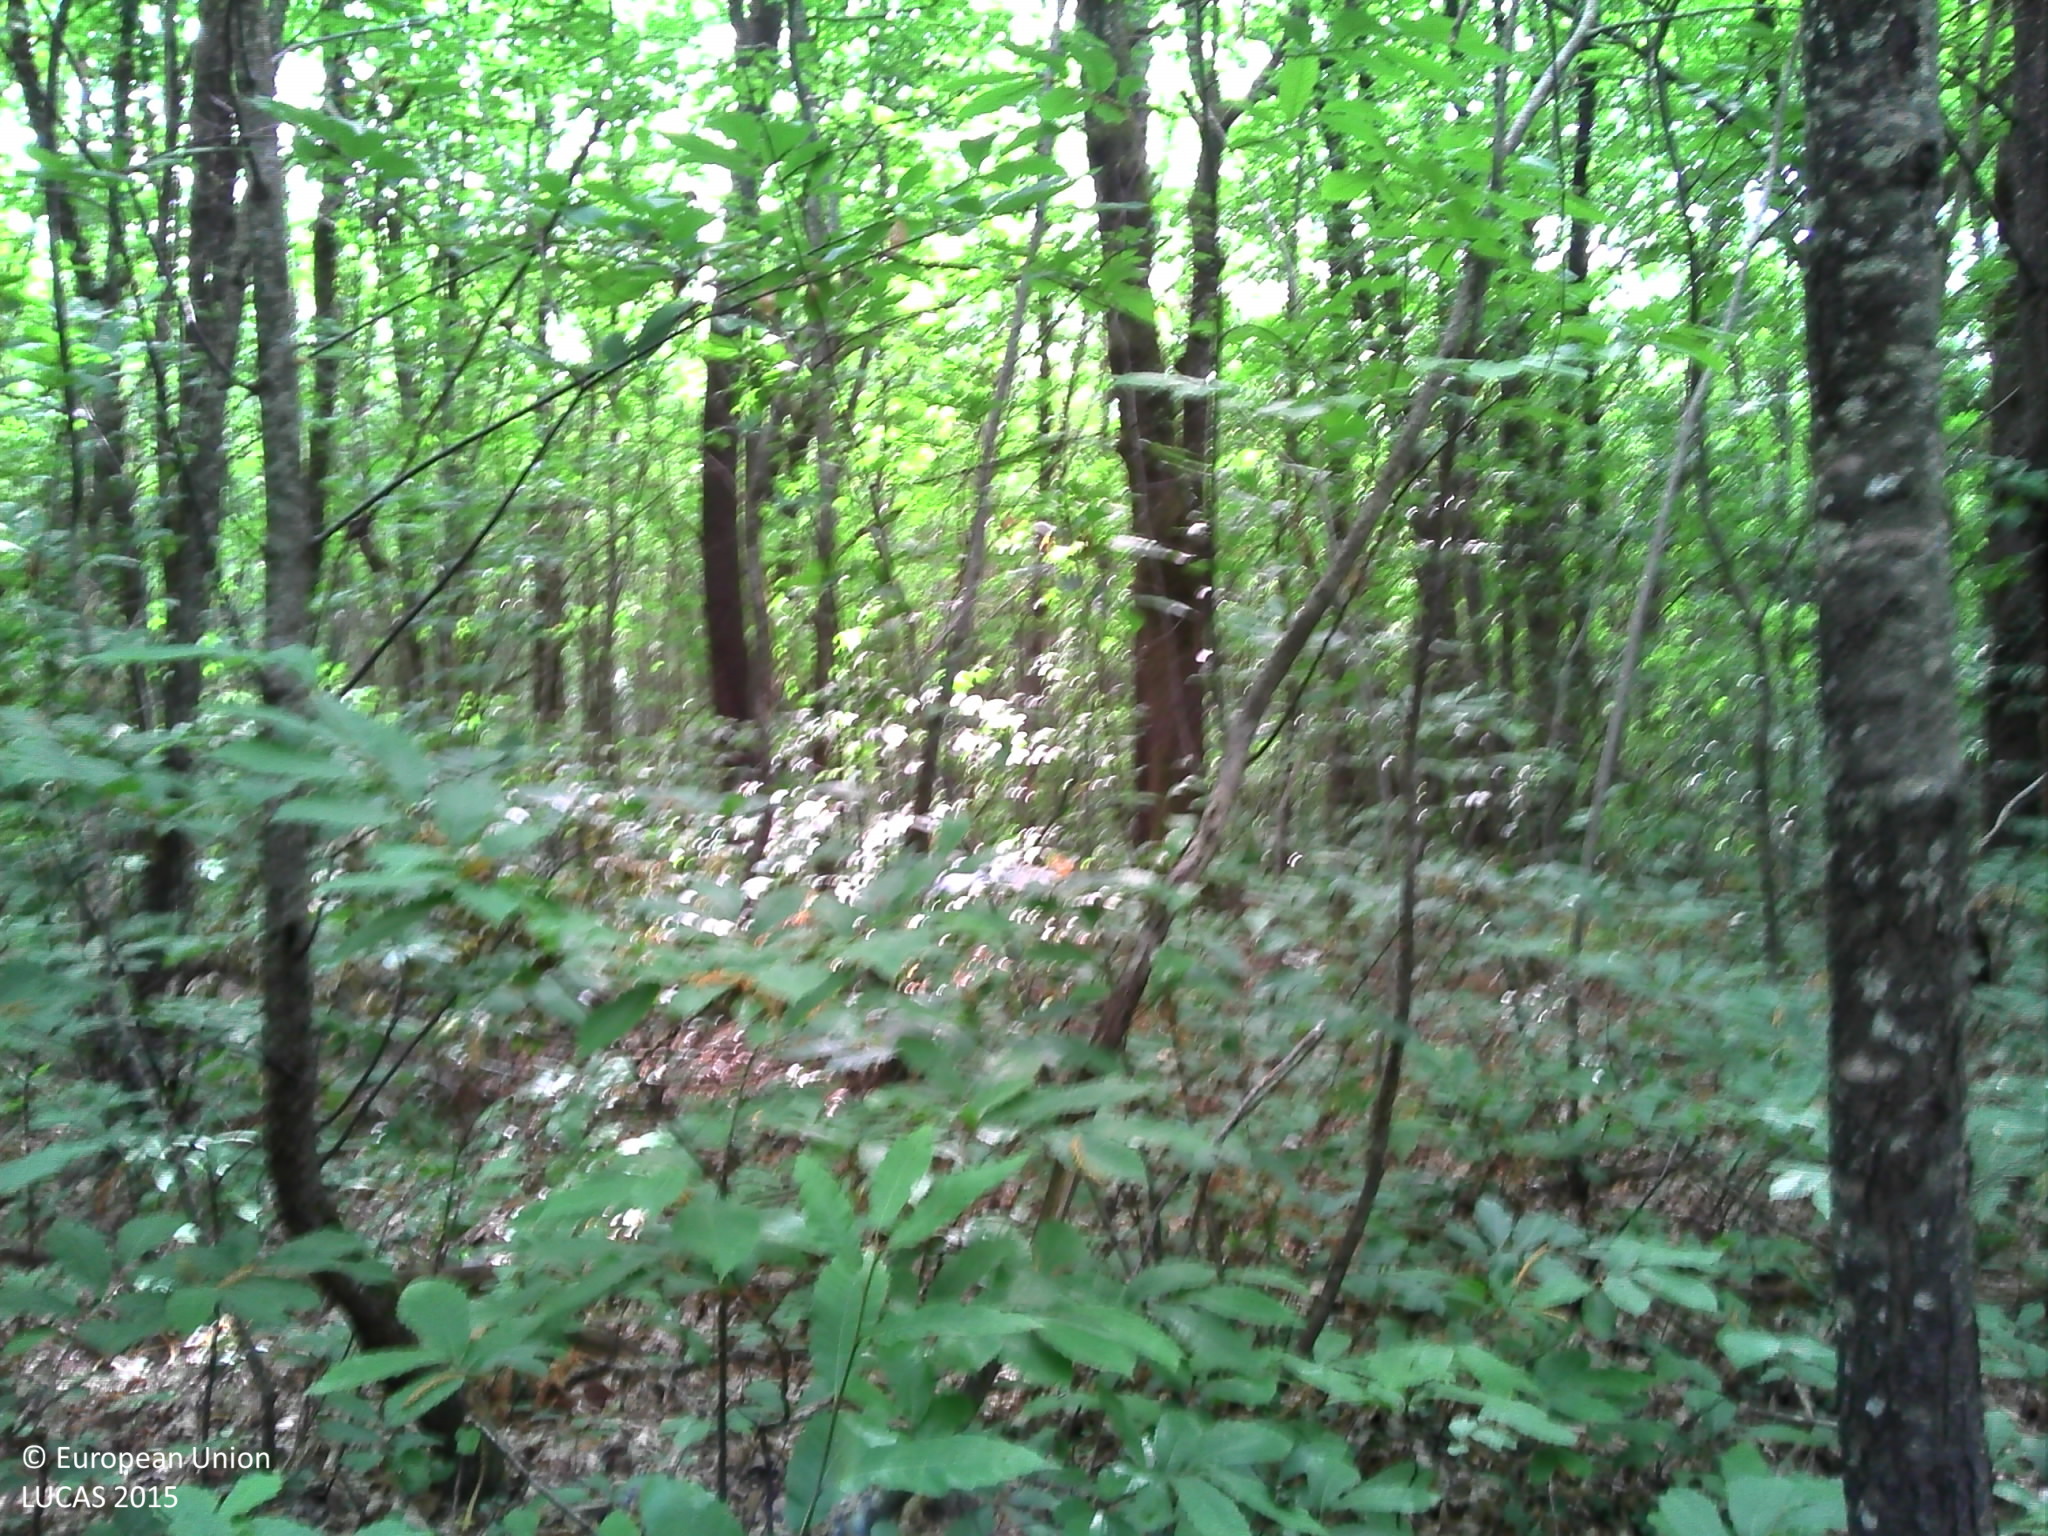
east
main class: Woodland
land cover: Broadleaved woodland
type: thermophilous deciduous forest
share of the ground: > 75 %
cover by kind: broadleaved forest trees 80 %, herbaceous plants 10 %, shrubs 5 %, lichens and mosses 5 %
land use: Forestry
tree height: > 5 m
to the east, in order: Broadleaved woodland; Grass margins; Paved roads, cycling and walking lanes; Grass margins; Electric lines; Broadleaved woodland
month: July
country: FR
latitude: 44.9906
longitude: 0.7703
